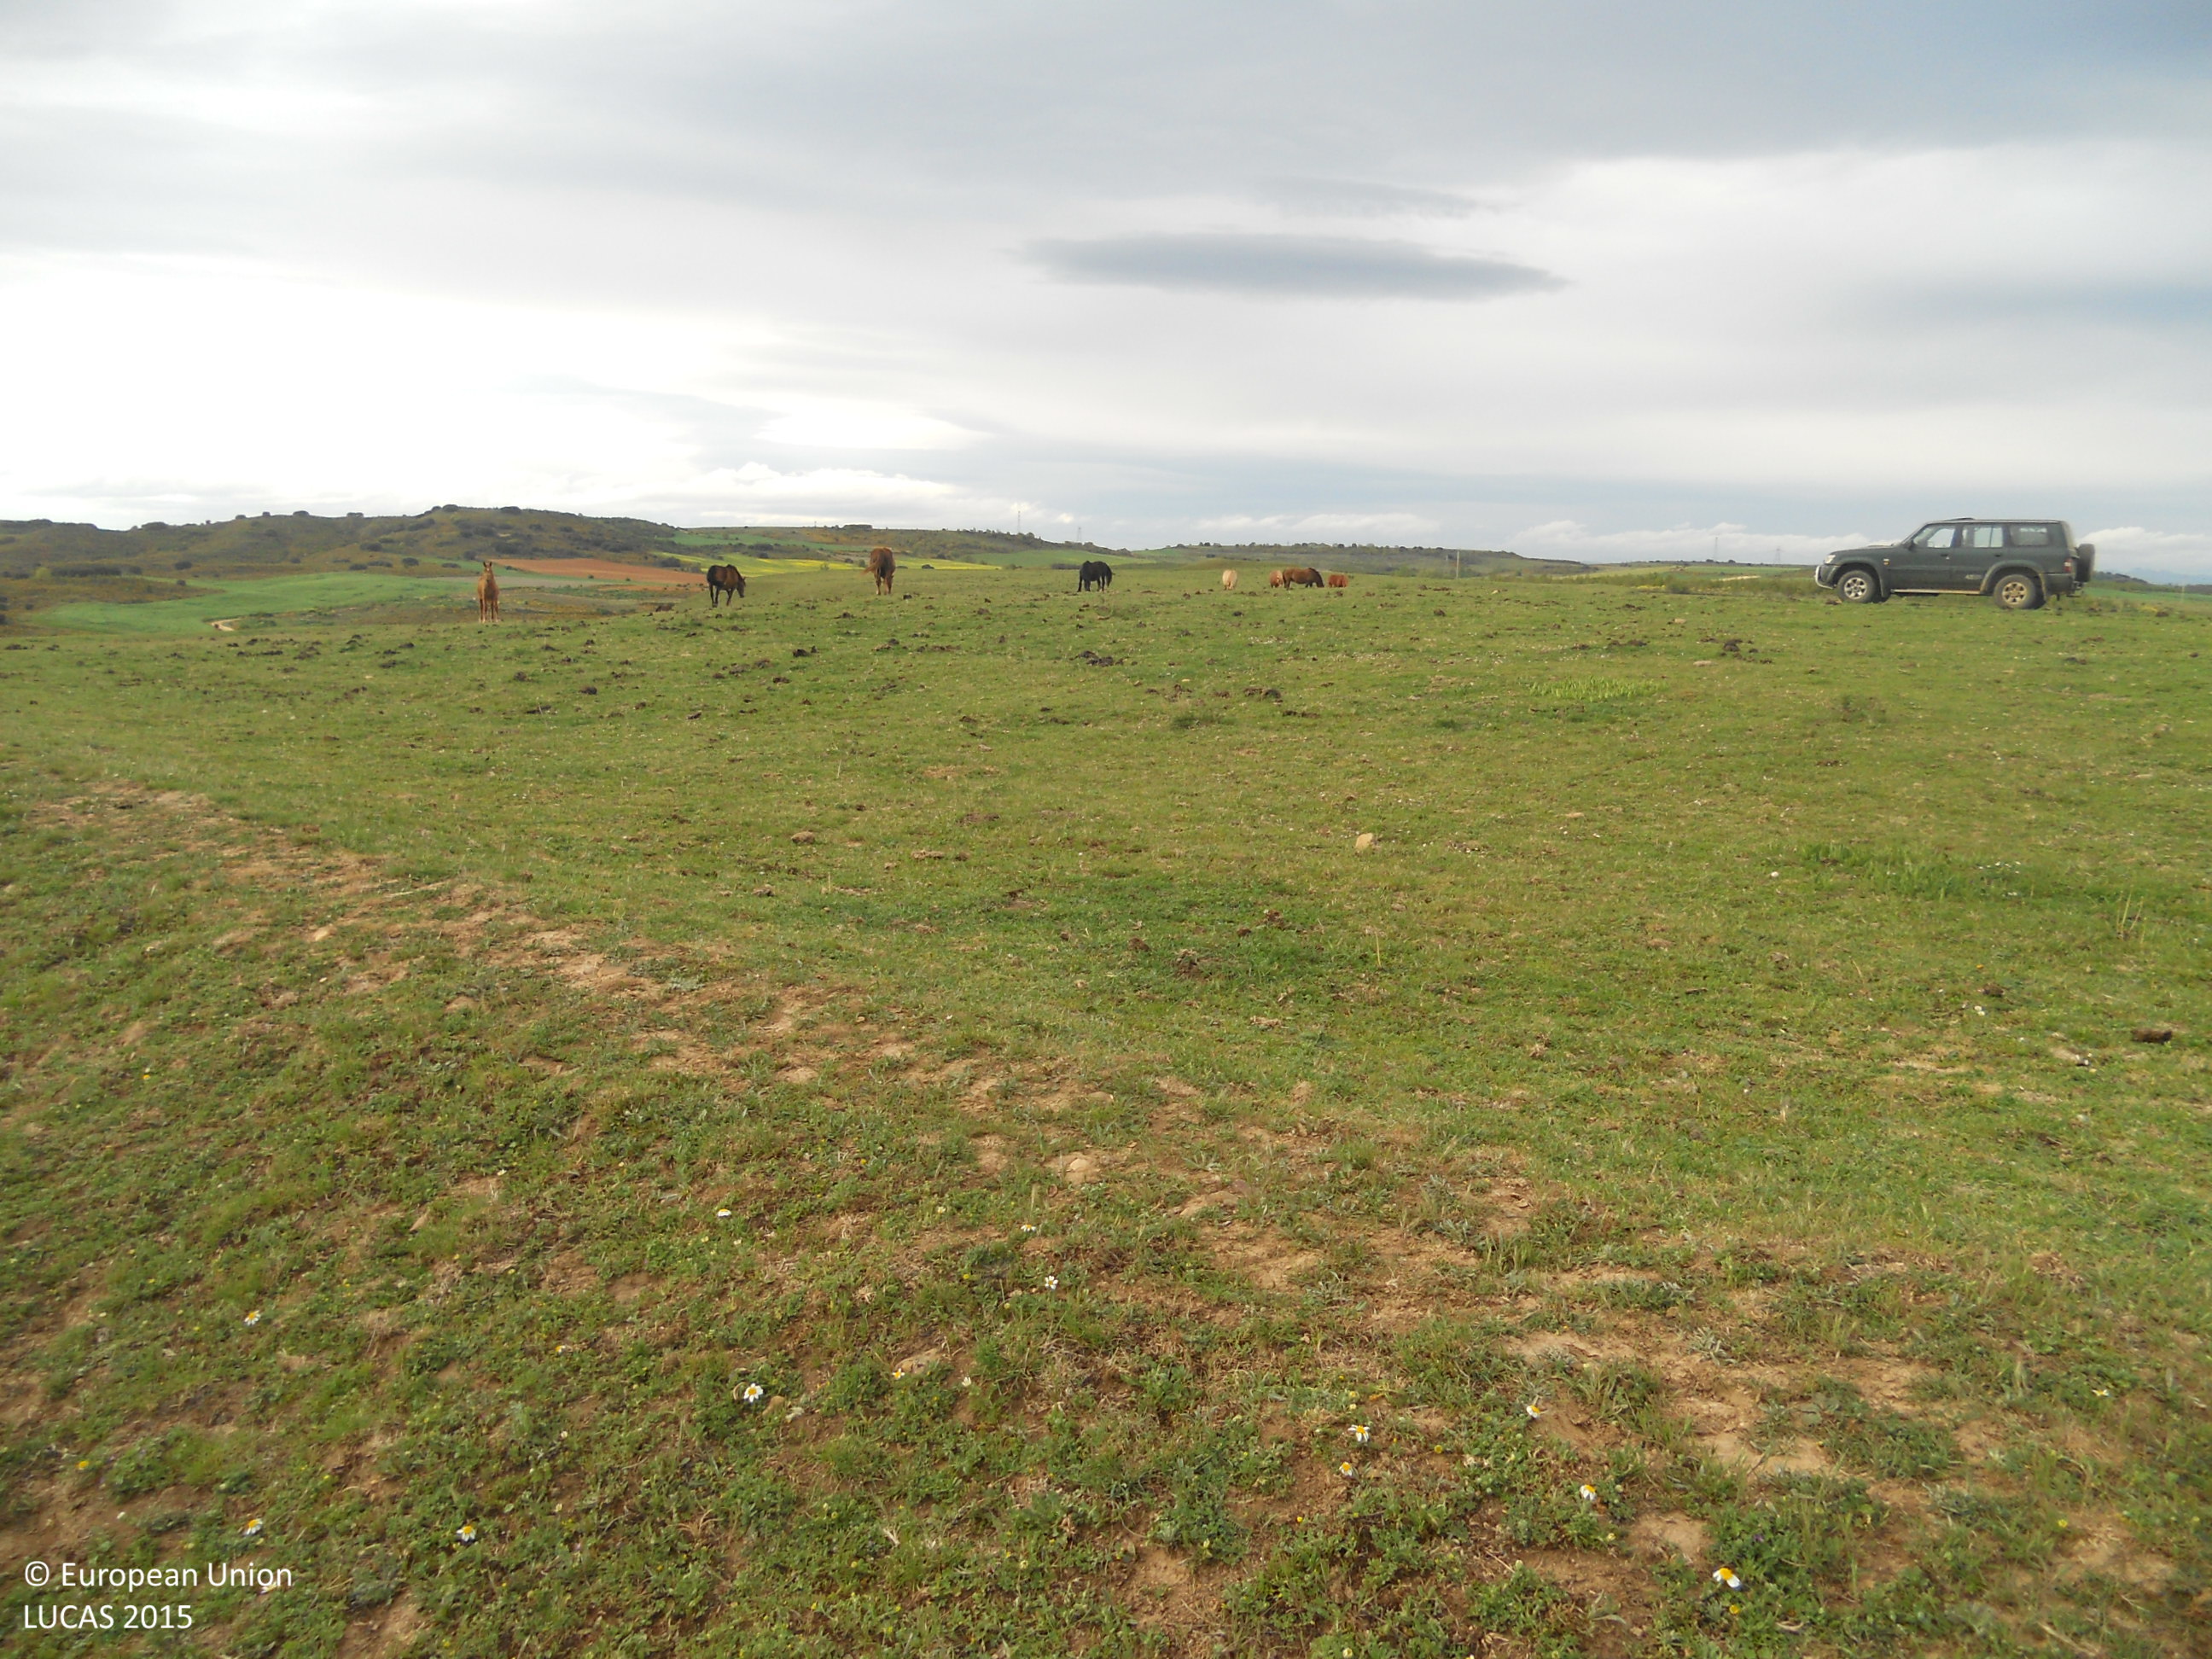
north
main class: Grassland
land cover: Grassland without tree/shrub cover
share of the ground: > 75 %
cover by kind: herbaceous plants 100 %
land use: Agriculture (excluding fallow land and kitchen gardens)
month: May
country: ES
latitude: 42.5403
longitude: -5.3488
